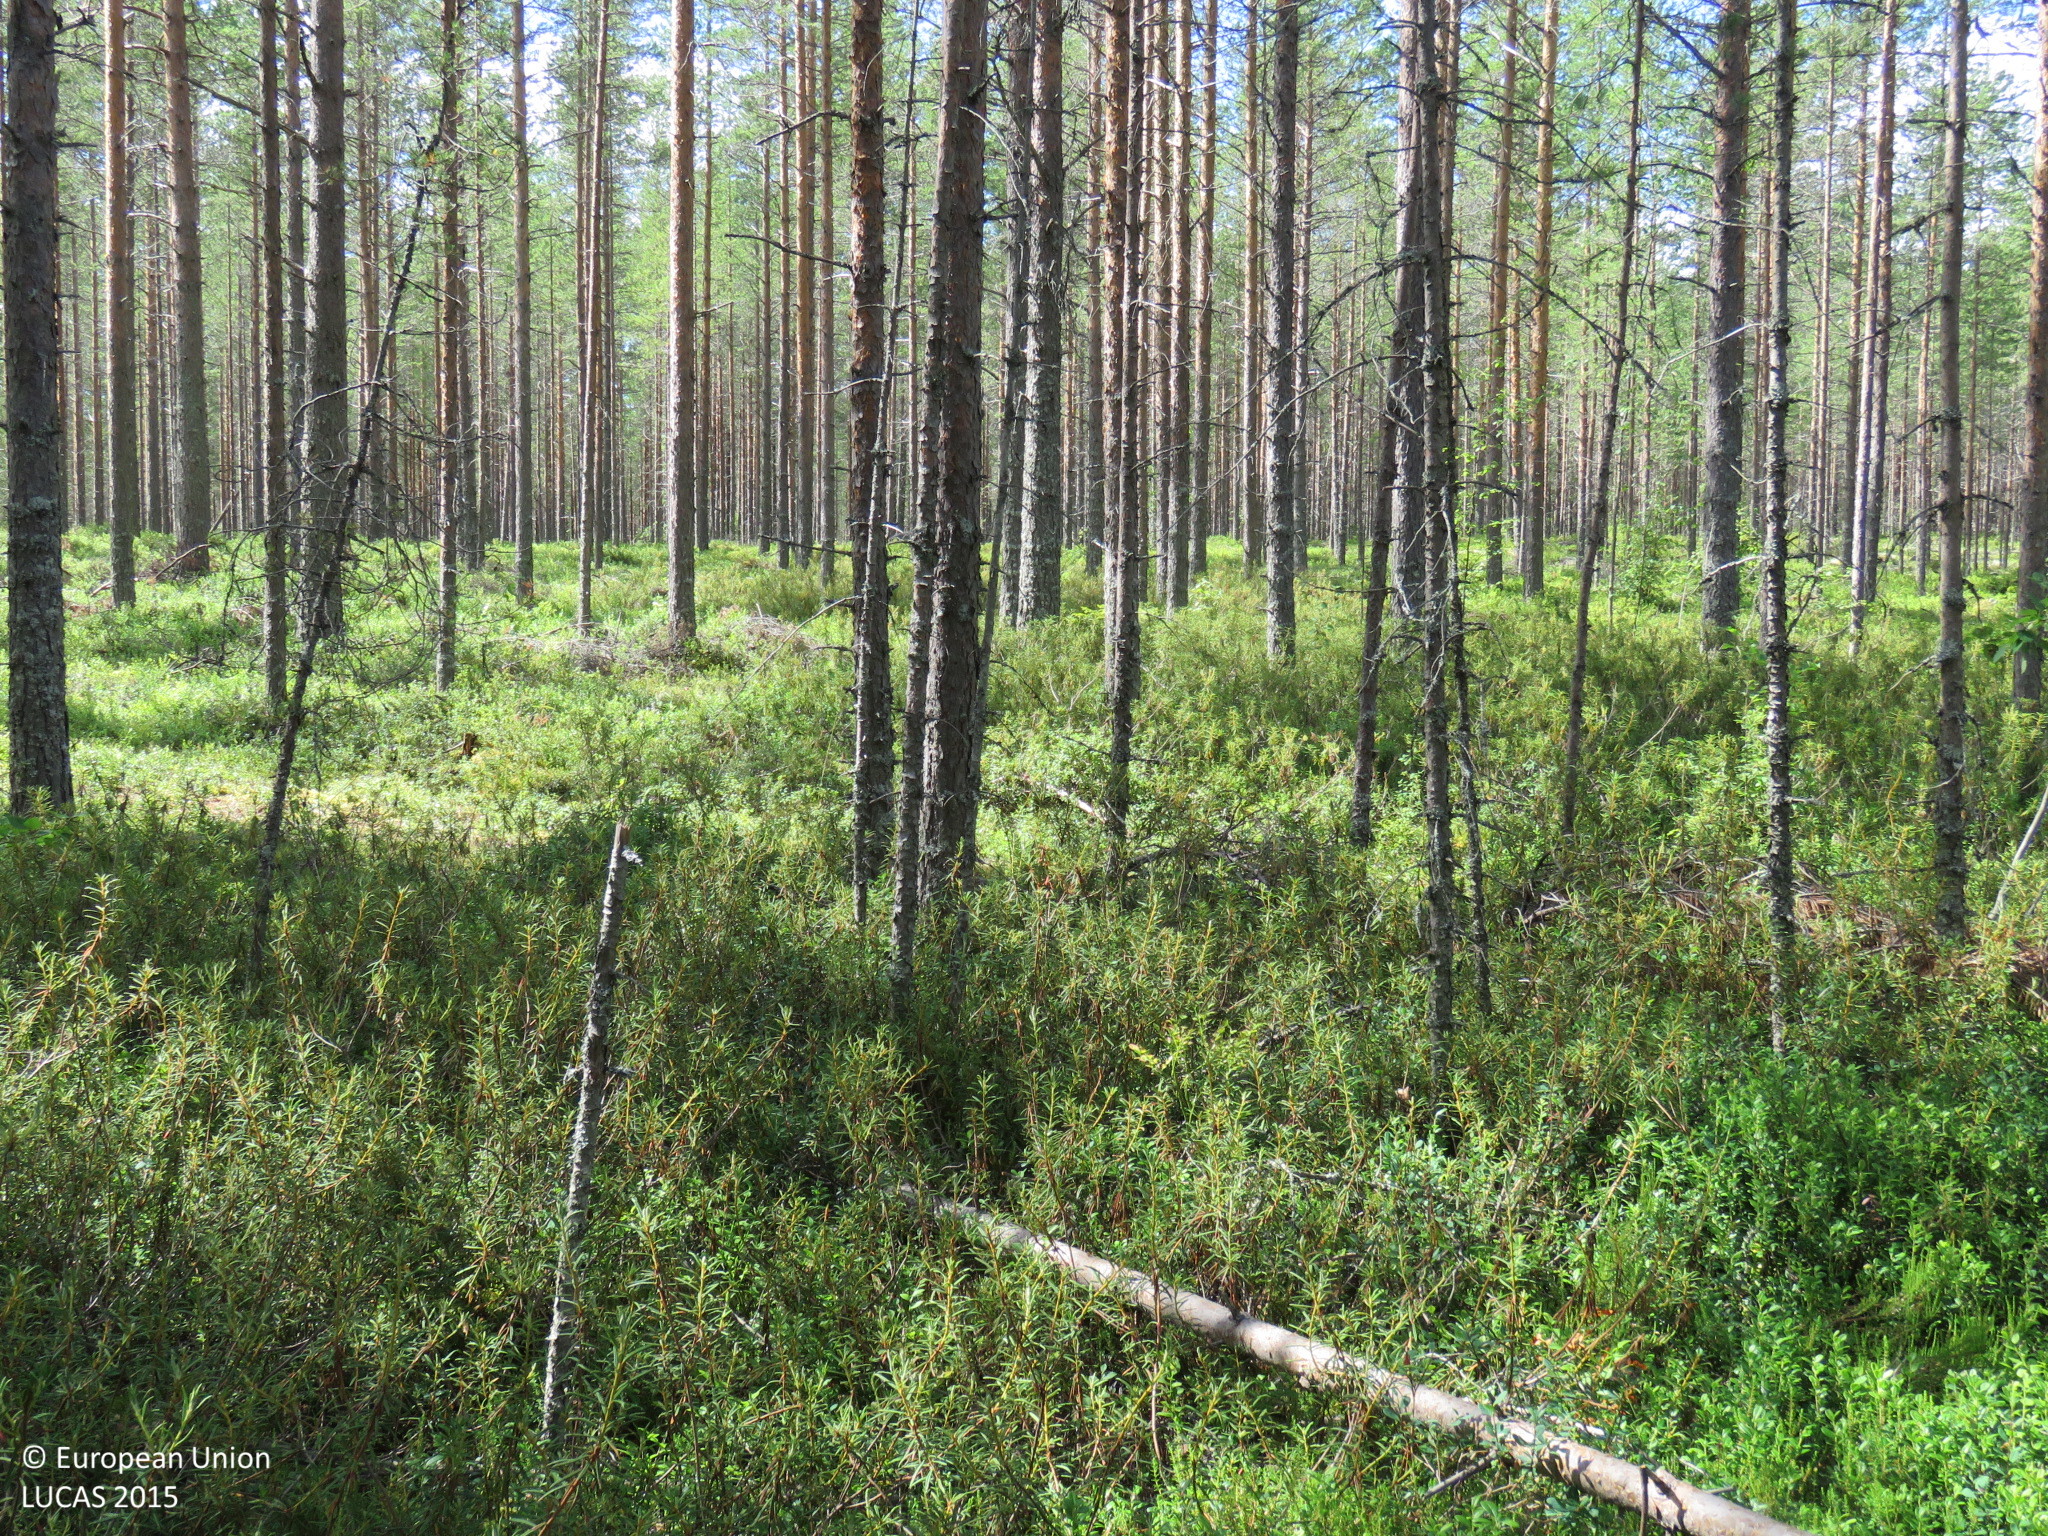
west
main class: Woodland
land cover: Pine dominated coniferous woodland
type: boreal forest
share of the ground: > 75 %
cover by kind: coniferous forest trees 70 %, shrubs 15 %, broadleaved forest trees 10 %, lichens and mosses 5 %
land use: Forestry
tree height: > 5 m
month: July
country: FI
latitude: 64.8395
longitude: 25.7975
